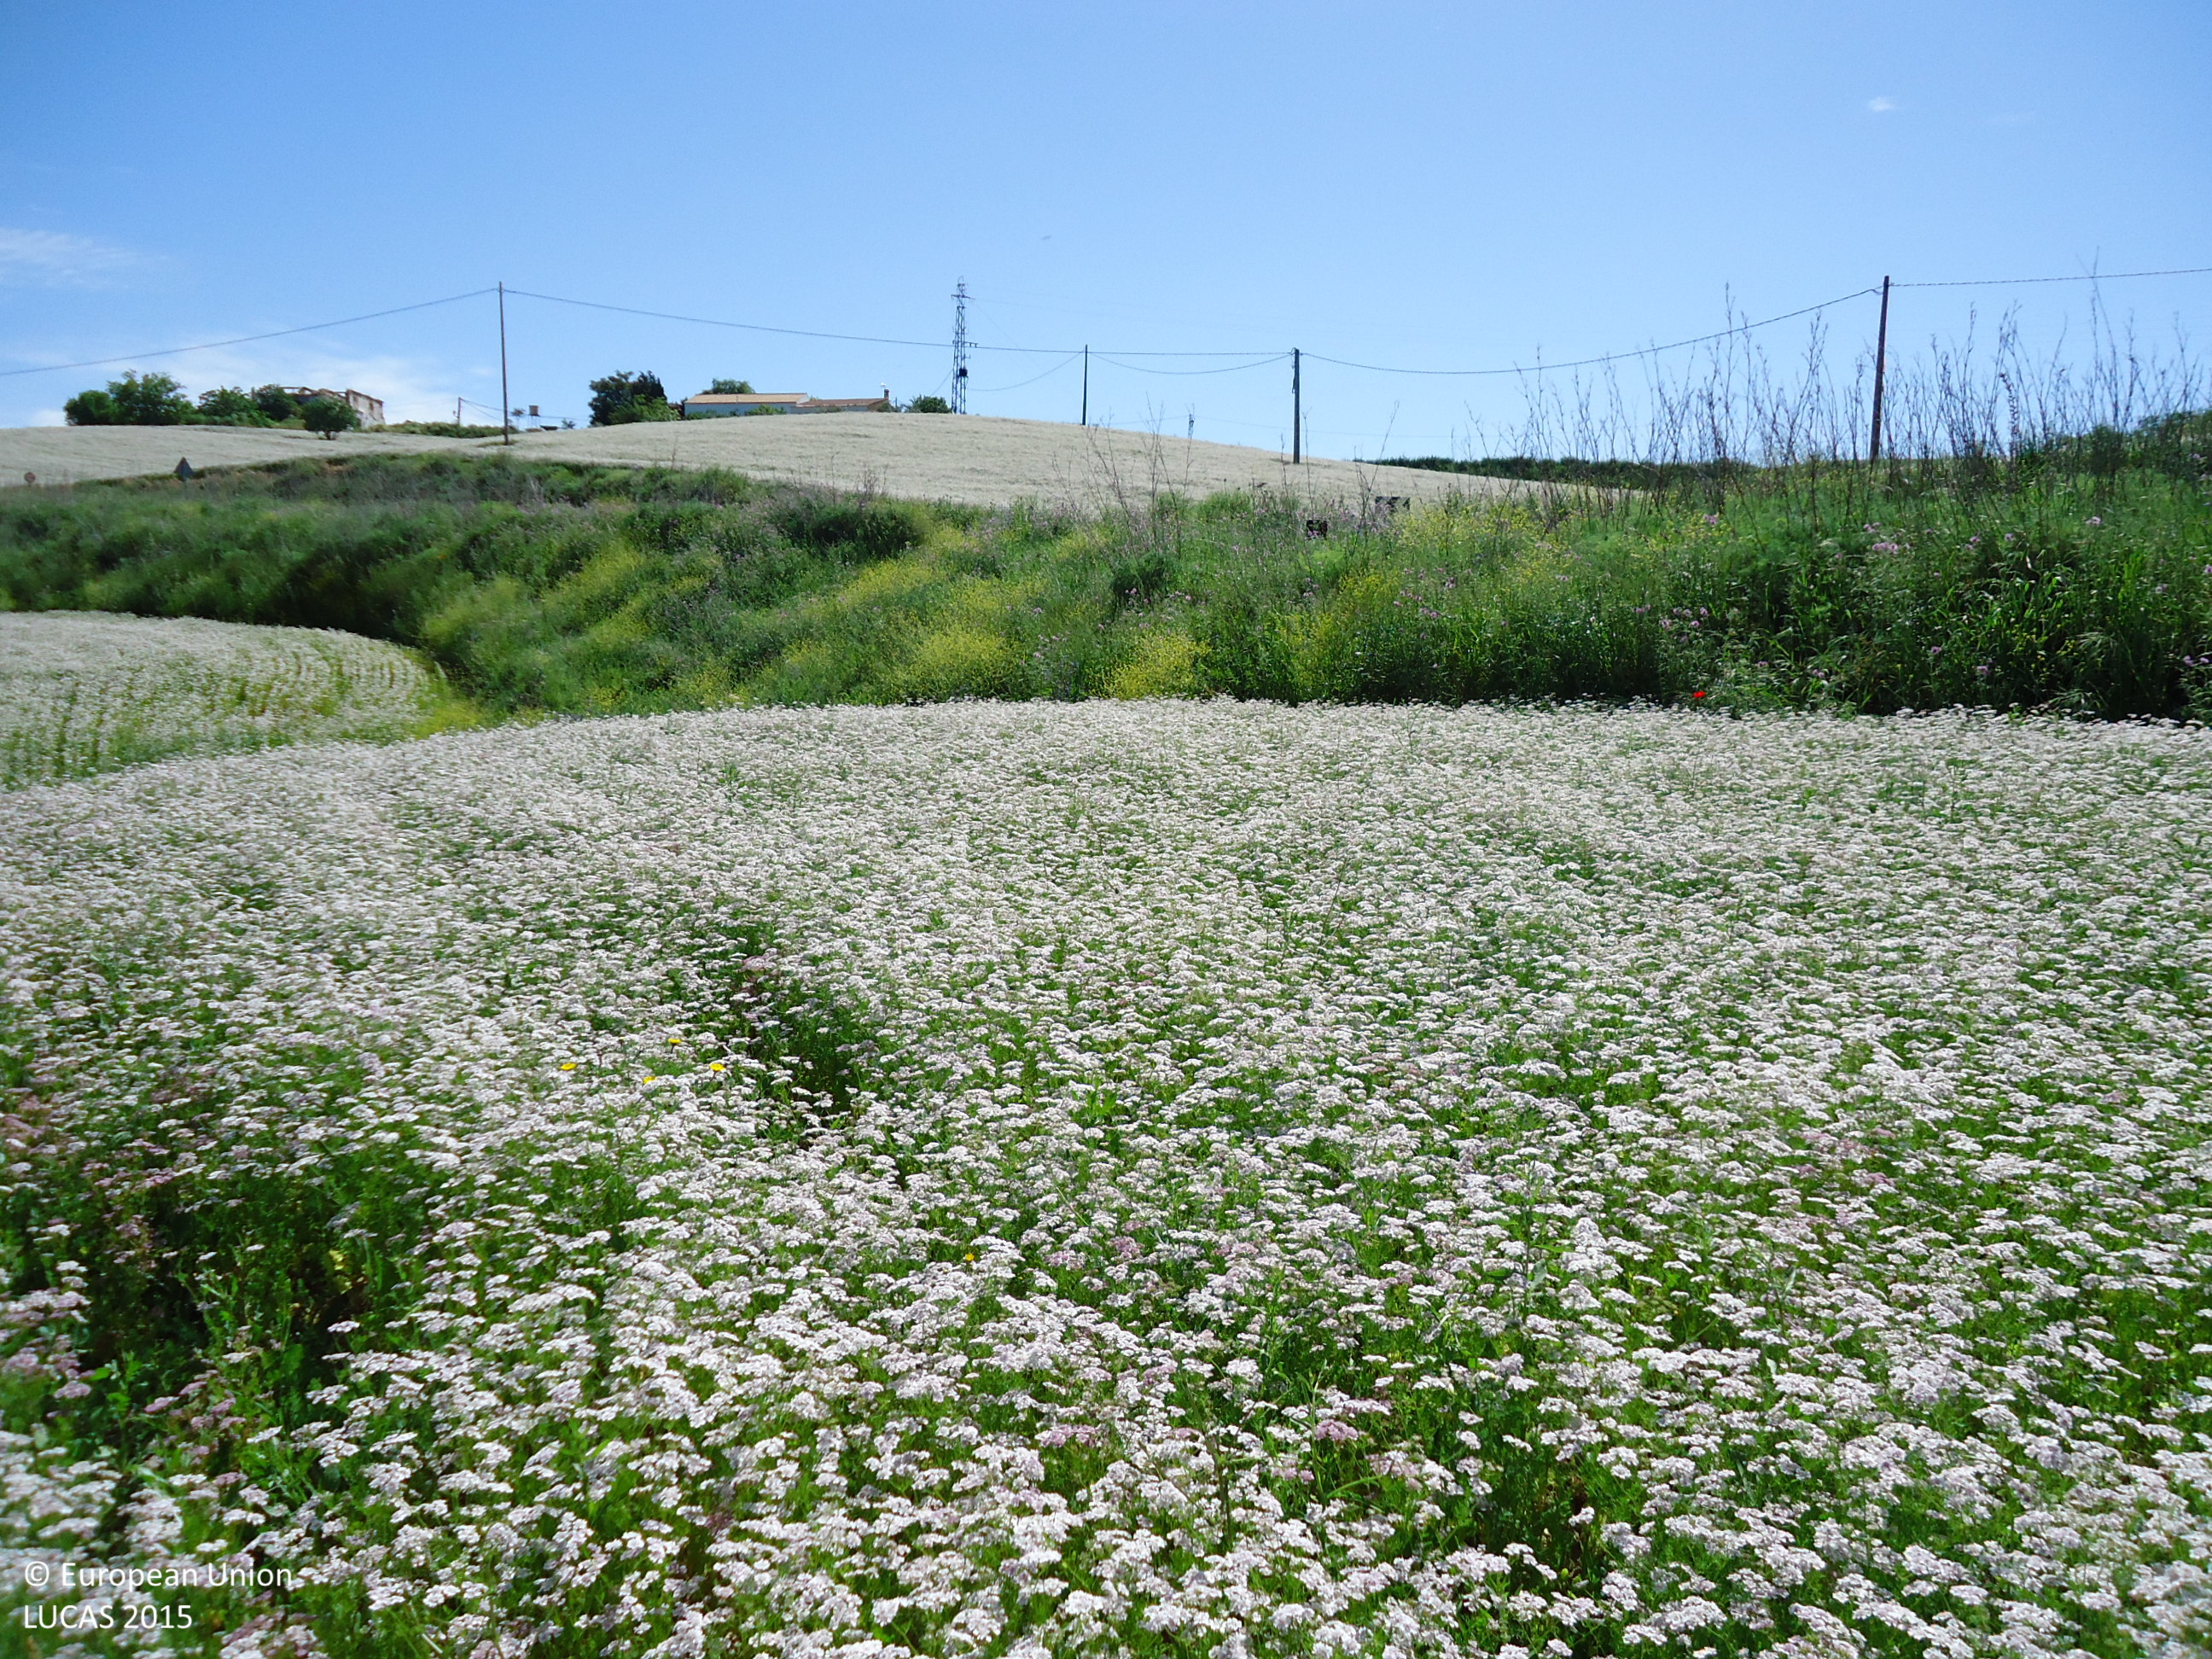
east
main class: Cropland
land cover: Other non-permanent industrial crops
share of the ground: > 75 %
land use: Agriculture (excluding fallow land and kitchen gardens)
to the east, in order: Other non-permanent industrial crops; Grassland without tree/shrub cover; Paved roads, cycling and walking lanes; Other structural elements; Grass margins; Other non-permanent industrial crops; Electric lines; Other non-permanent industrial crops; Grassland without tree/shrub cover; Paved roads, cycling and walking lanes; Grass margins; Common wheat
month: May
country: ES
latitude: 36.8567
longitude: -5.2677
